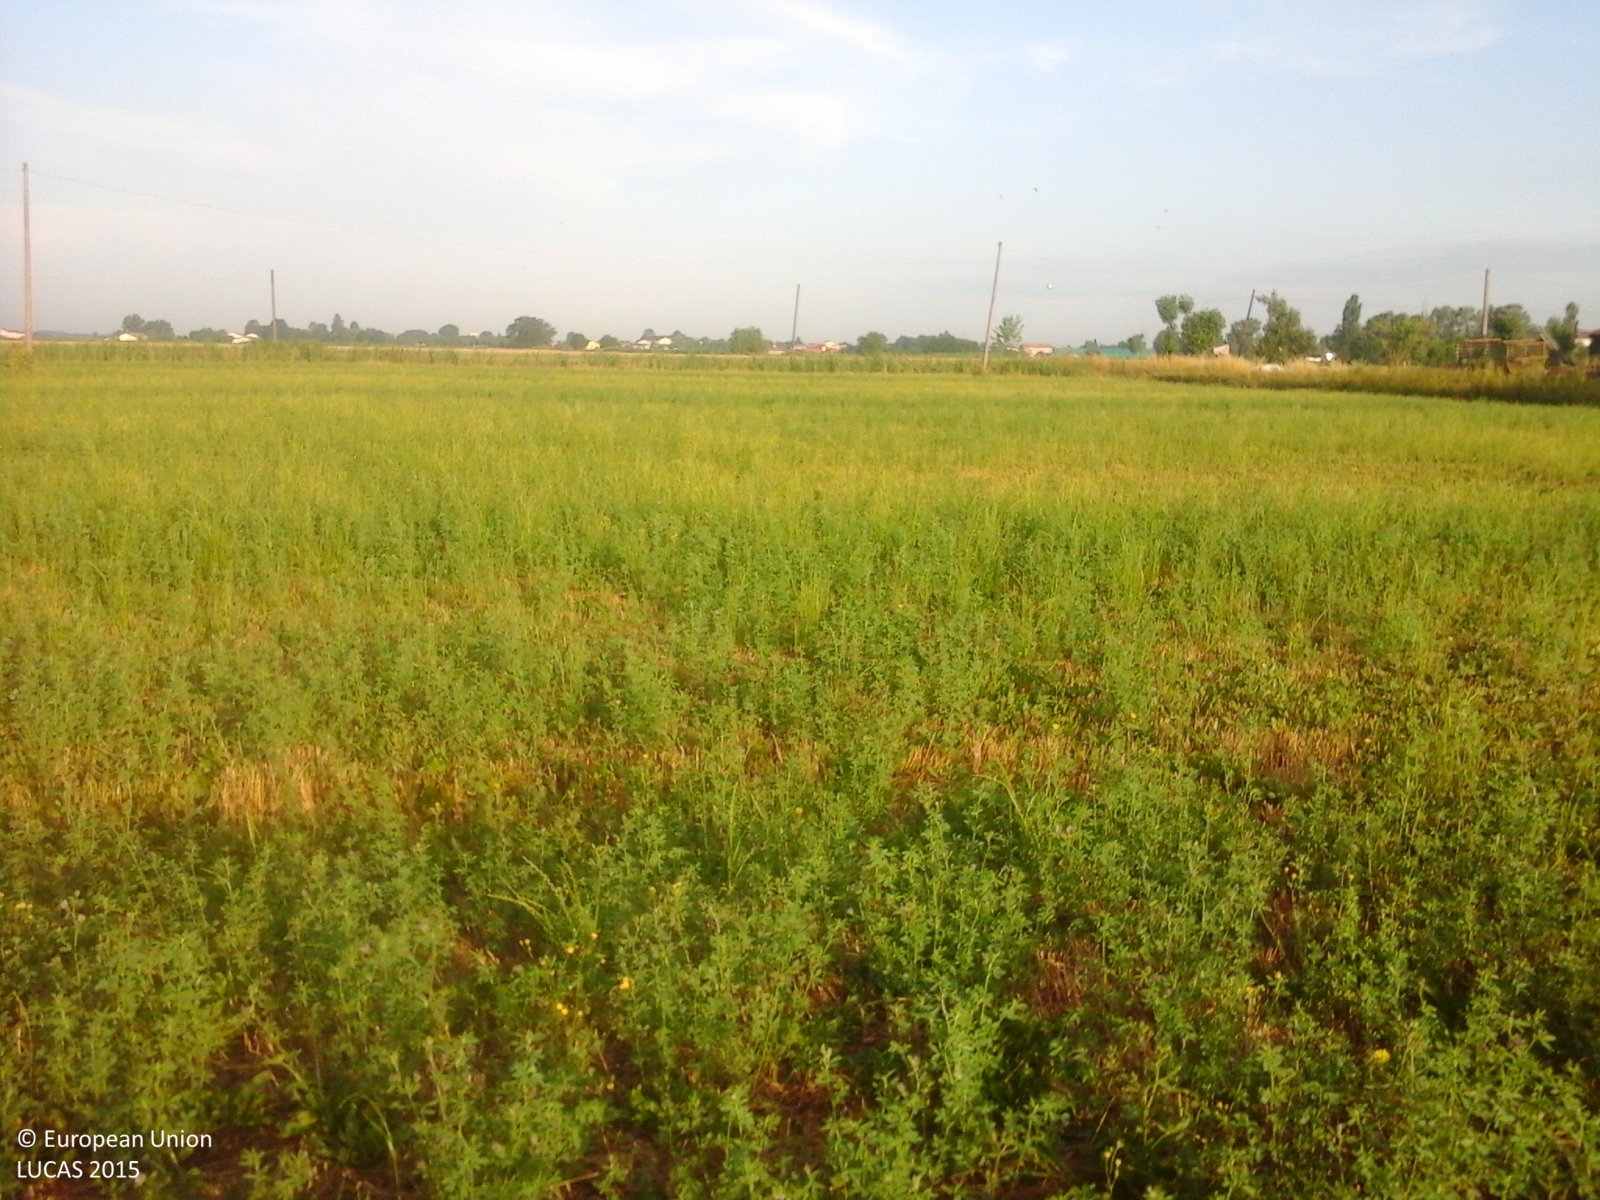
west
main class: Cropland
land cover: Lucerne
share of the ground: > 75 %
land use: Agriculture (excluding fallow land and kitchen gardens)
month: June
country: IT
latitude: 44.9406
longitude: 11.0245
